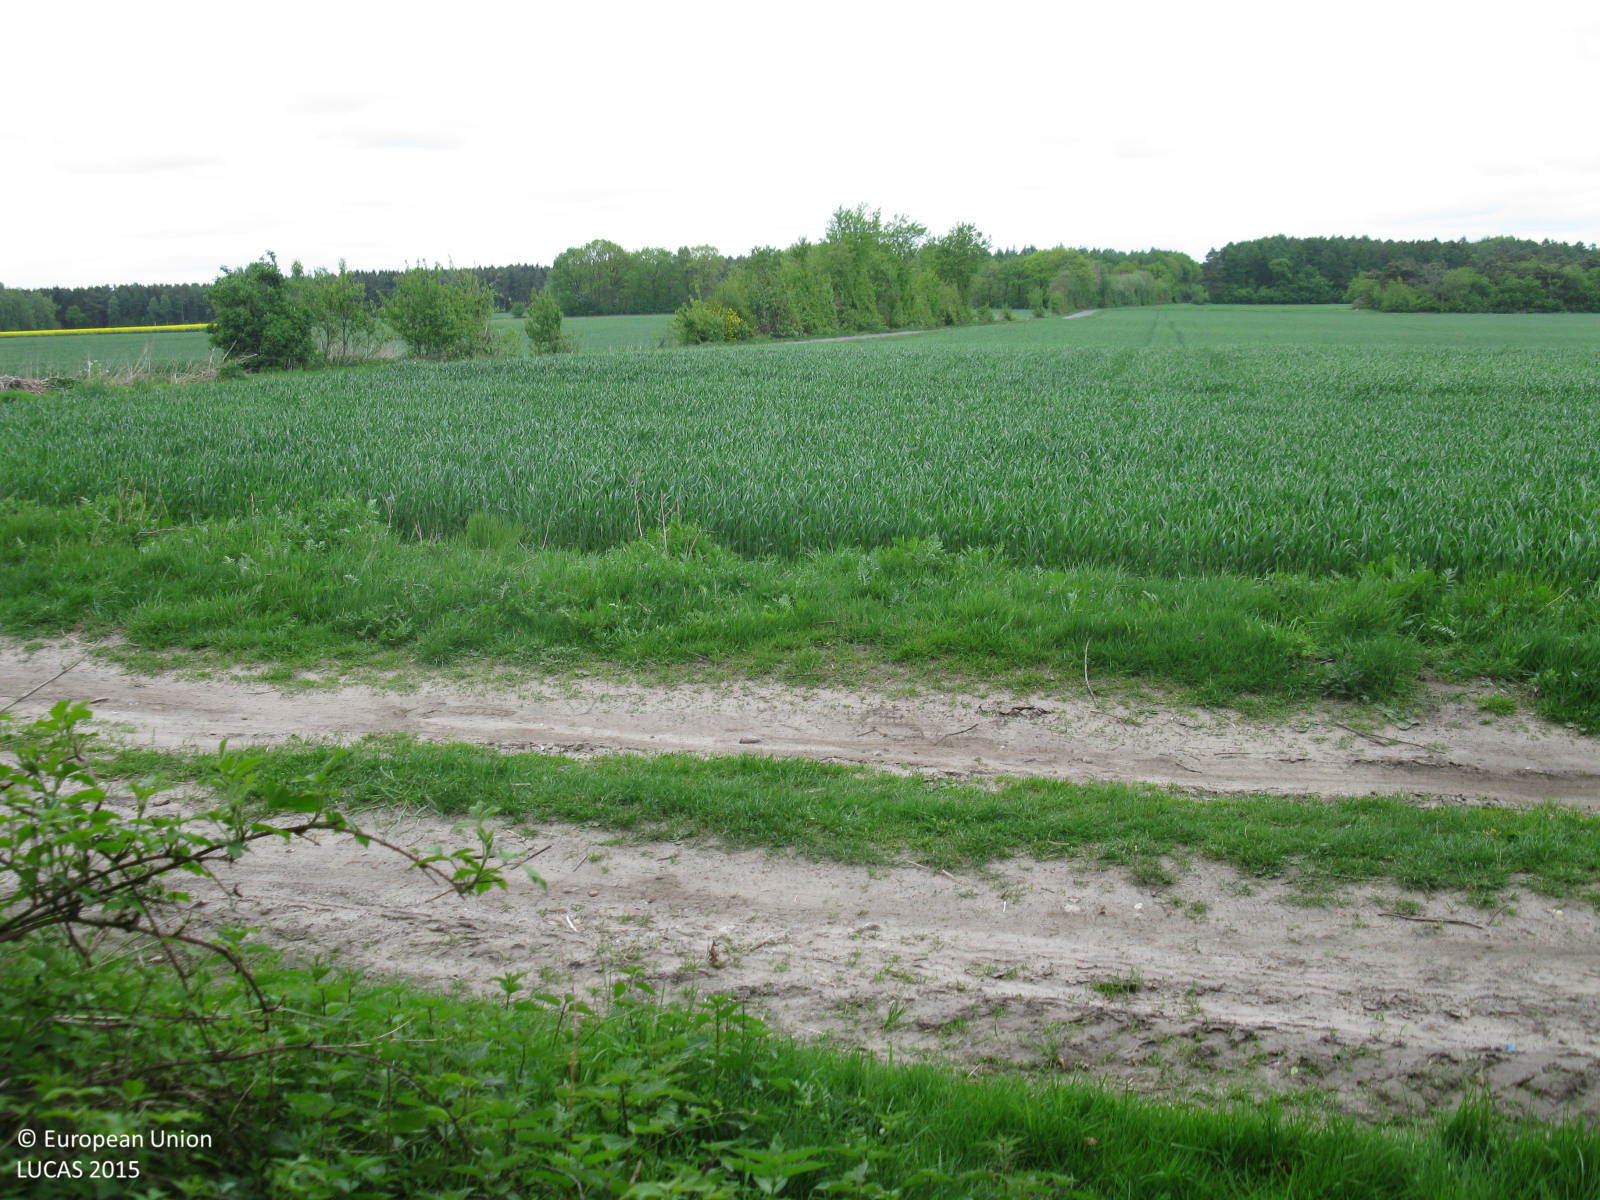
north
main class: Grassland
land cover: Spontaneously vegetated surfaces
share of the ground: > 75 %
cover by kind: herbaceous plants 100 %
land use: Semi-natural and natural areas not in use
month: May
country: DE
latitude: 52.7974
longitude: 7.3456
